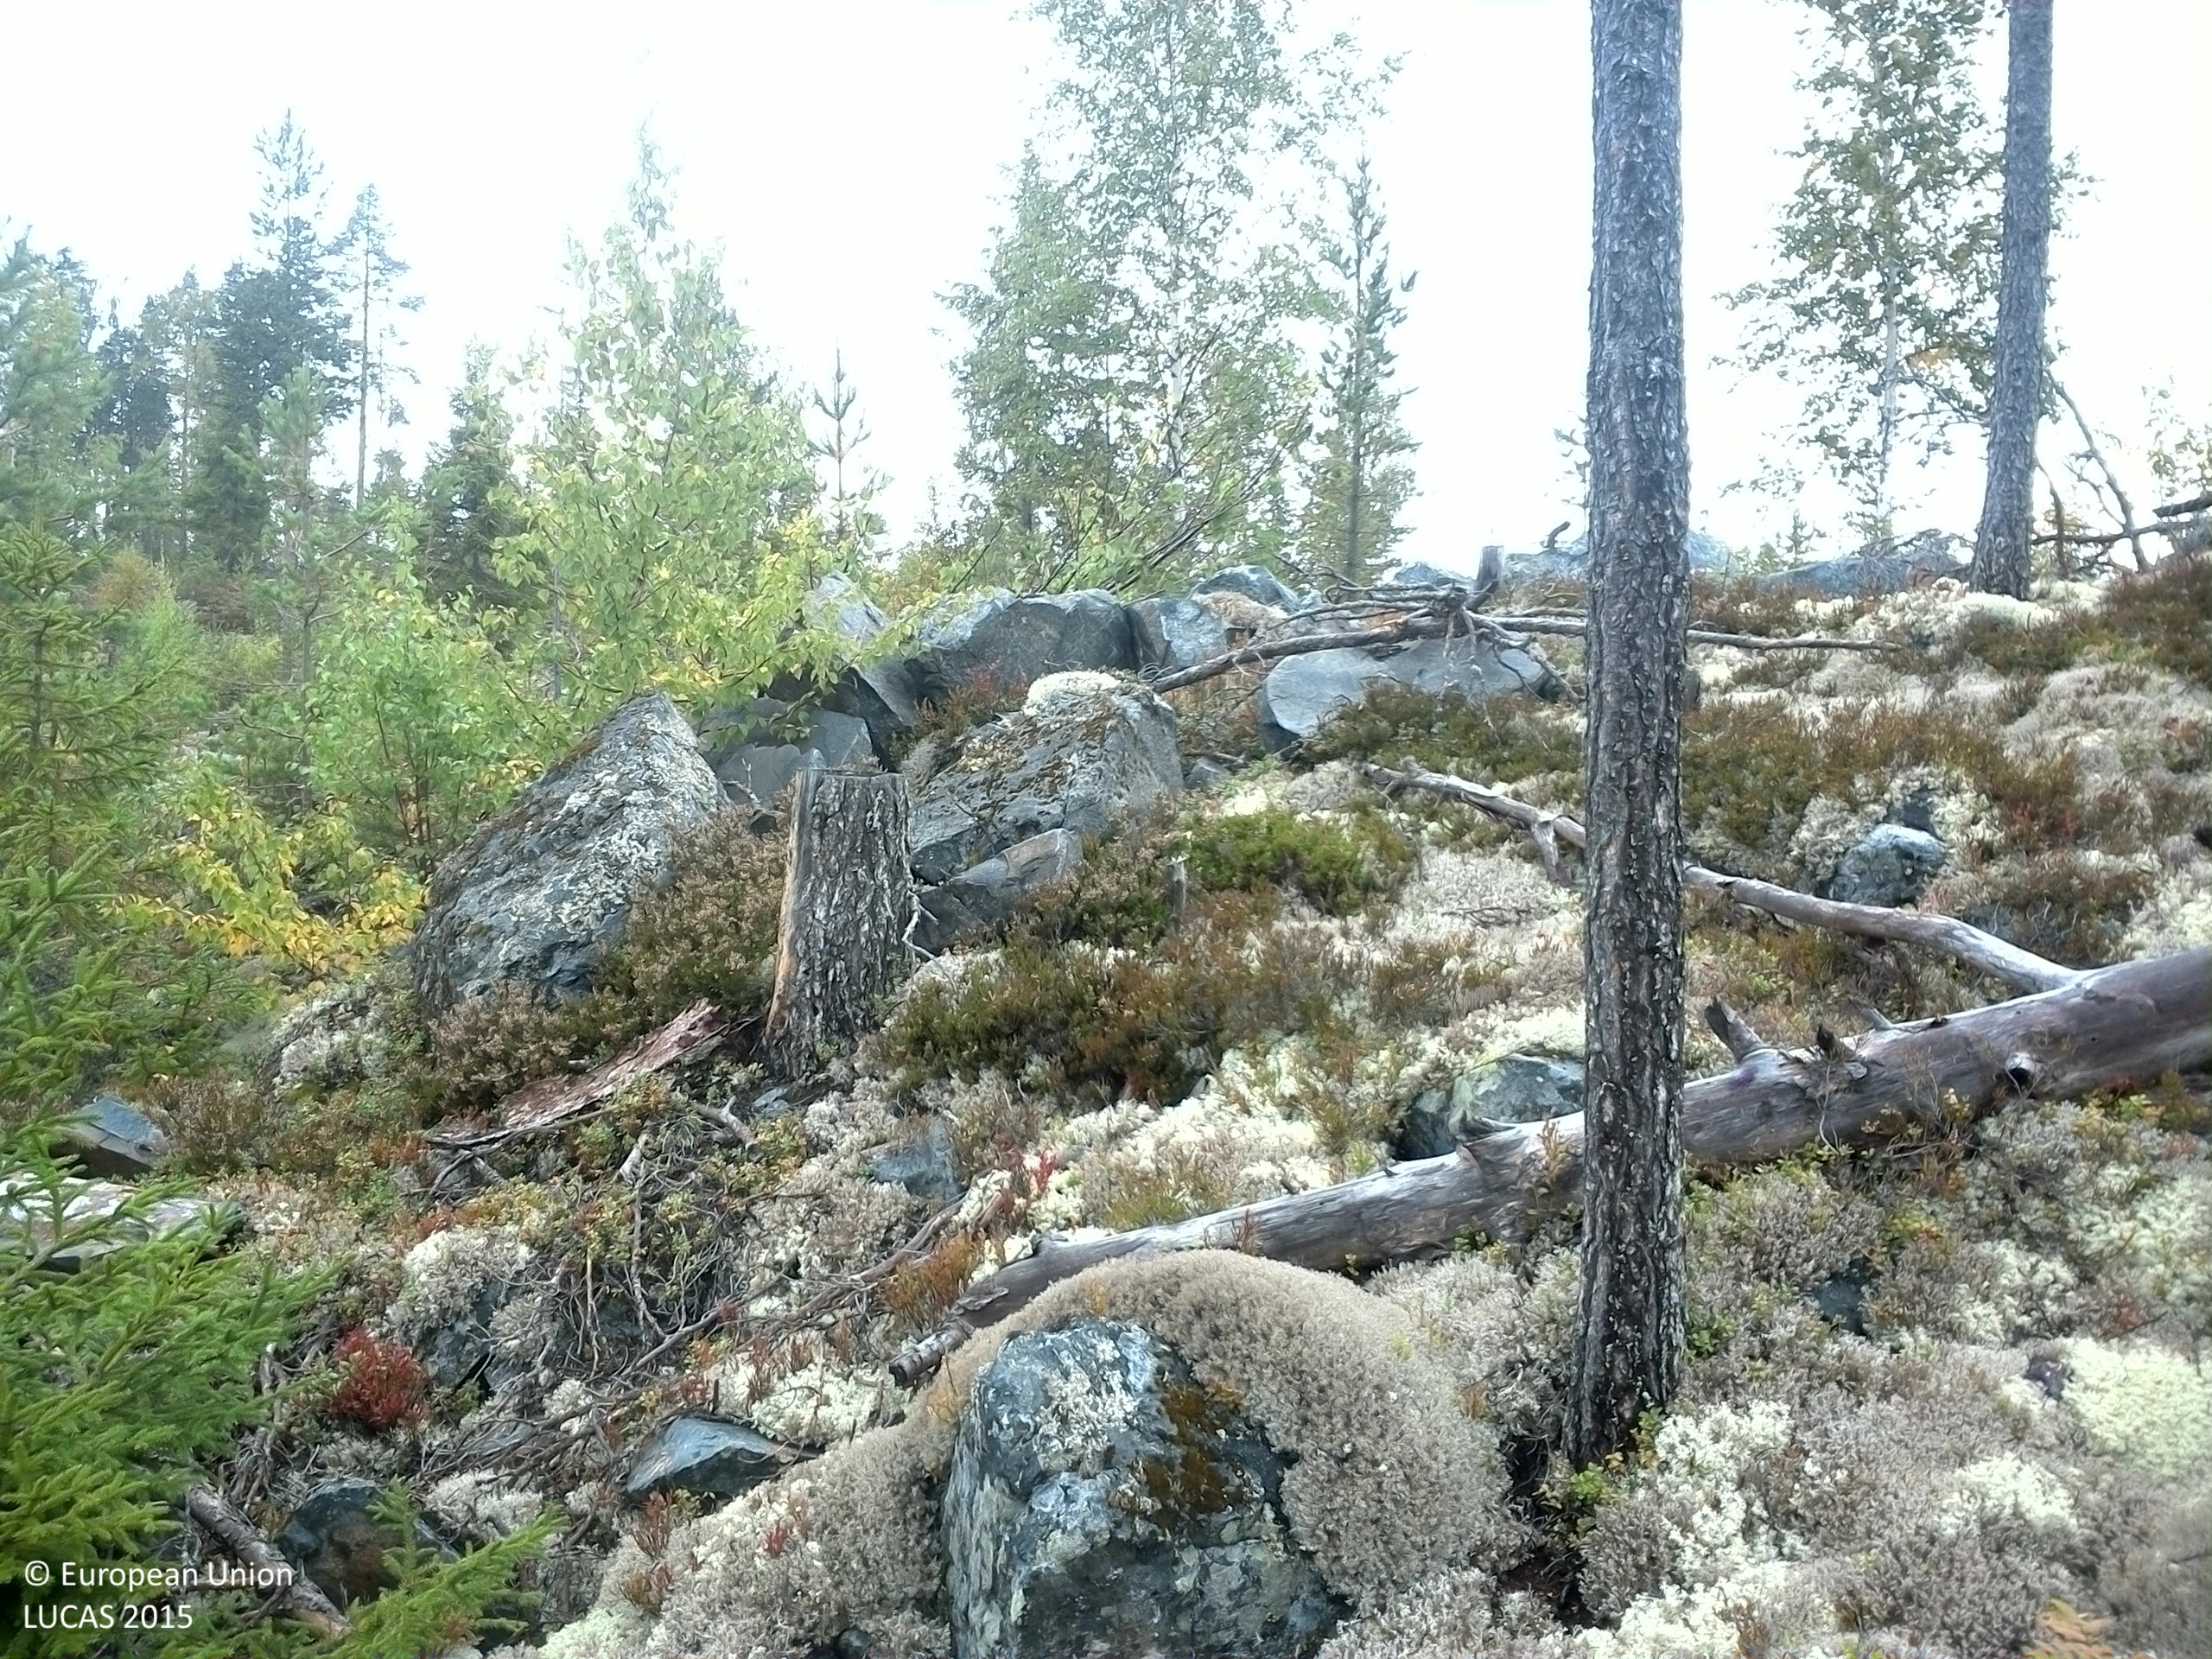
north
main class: Woodland
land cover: Pine dominated mixed woodland
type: boreal forest
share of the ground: 10 - 25 %
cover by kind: shrubs 55 %, lichens and mosses 20 %, coniferous forest trees 10 %, consolidated bare surface 10 %, broadleaved forest trees 5 %
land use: Forestry
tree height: < 5 m
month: September
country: SE
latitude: 61.6935
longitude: 15.1443
